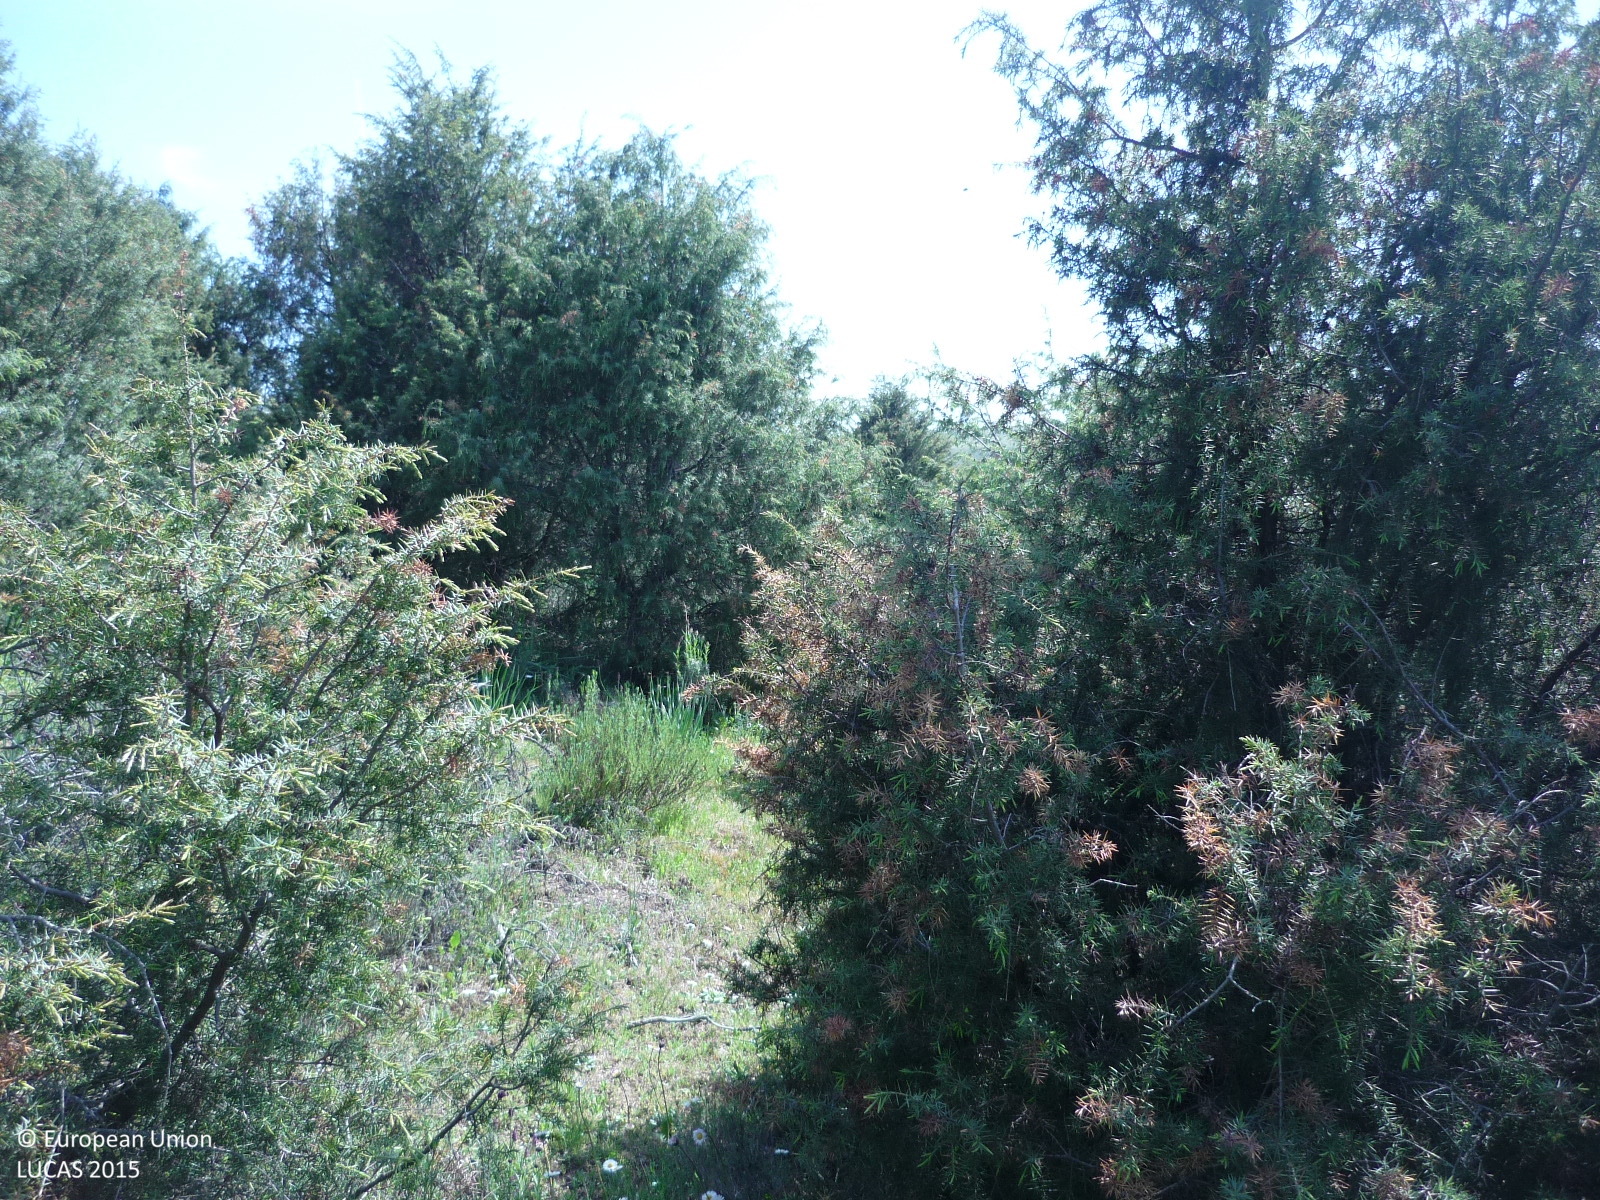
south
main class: Woodland
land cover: Spruce dominated coniferous woodland
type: coniferous forest of the mediterranean region
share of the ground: > 75 %
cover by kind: coniferous forest trees 75 %, shrubs 15 %, herbaceous plants 10 %
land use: Semi-natural and natural areas not in use
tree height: < 5 m
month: April
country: ES
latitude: 40.7584
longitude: -3.6275
